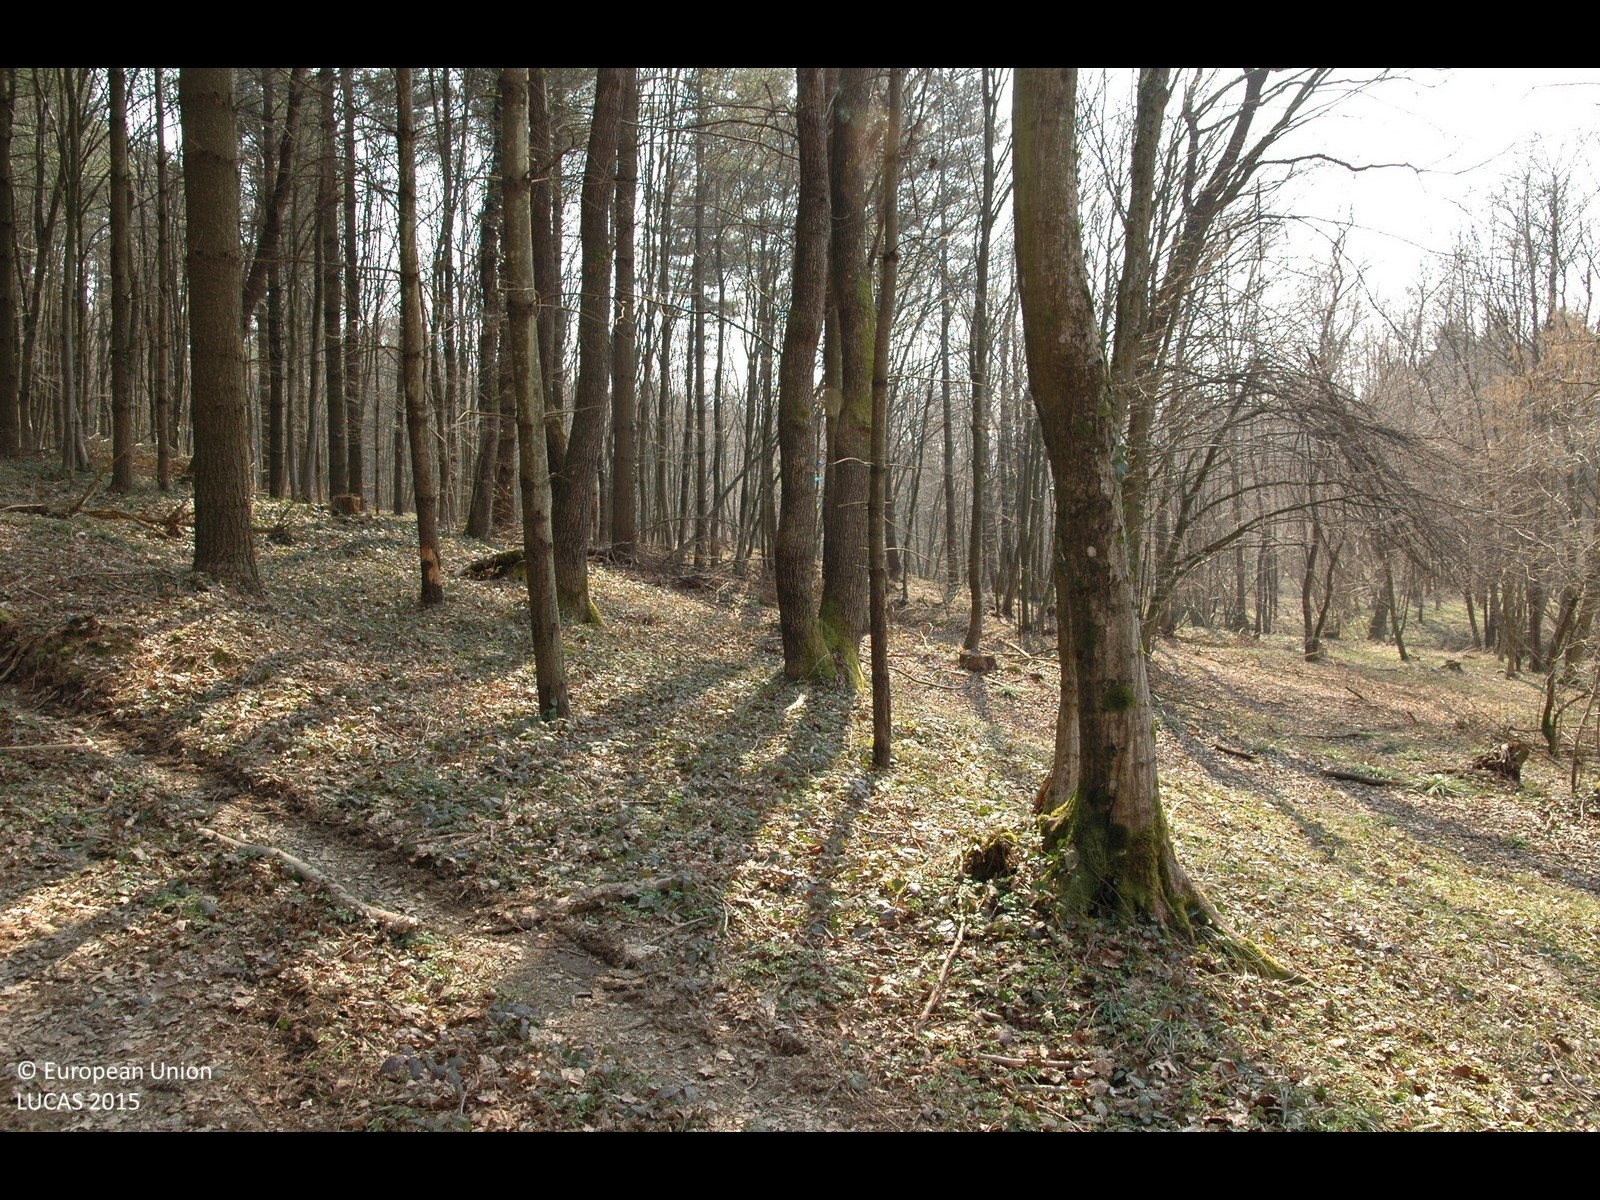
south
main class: Woodland
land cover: Broadleaved woodland
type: mesophytic deciduous forest
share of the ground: > 75 %
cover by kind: broadleaved forest trees 95 %, coniferous forest trees 5 %
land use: Forestry
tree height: > 5 m
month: March
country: HR
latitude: 46.2470
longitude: 16.4465
